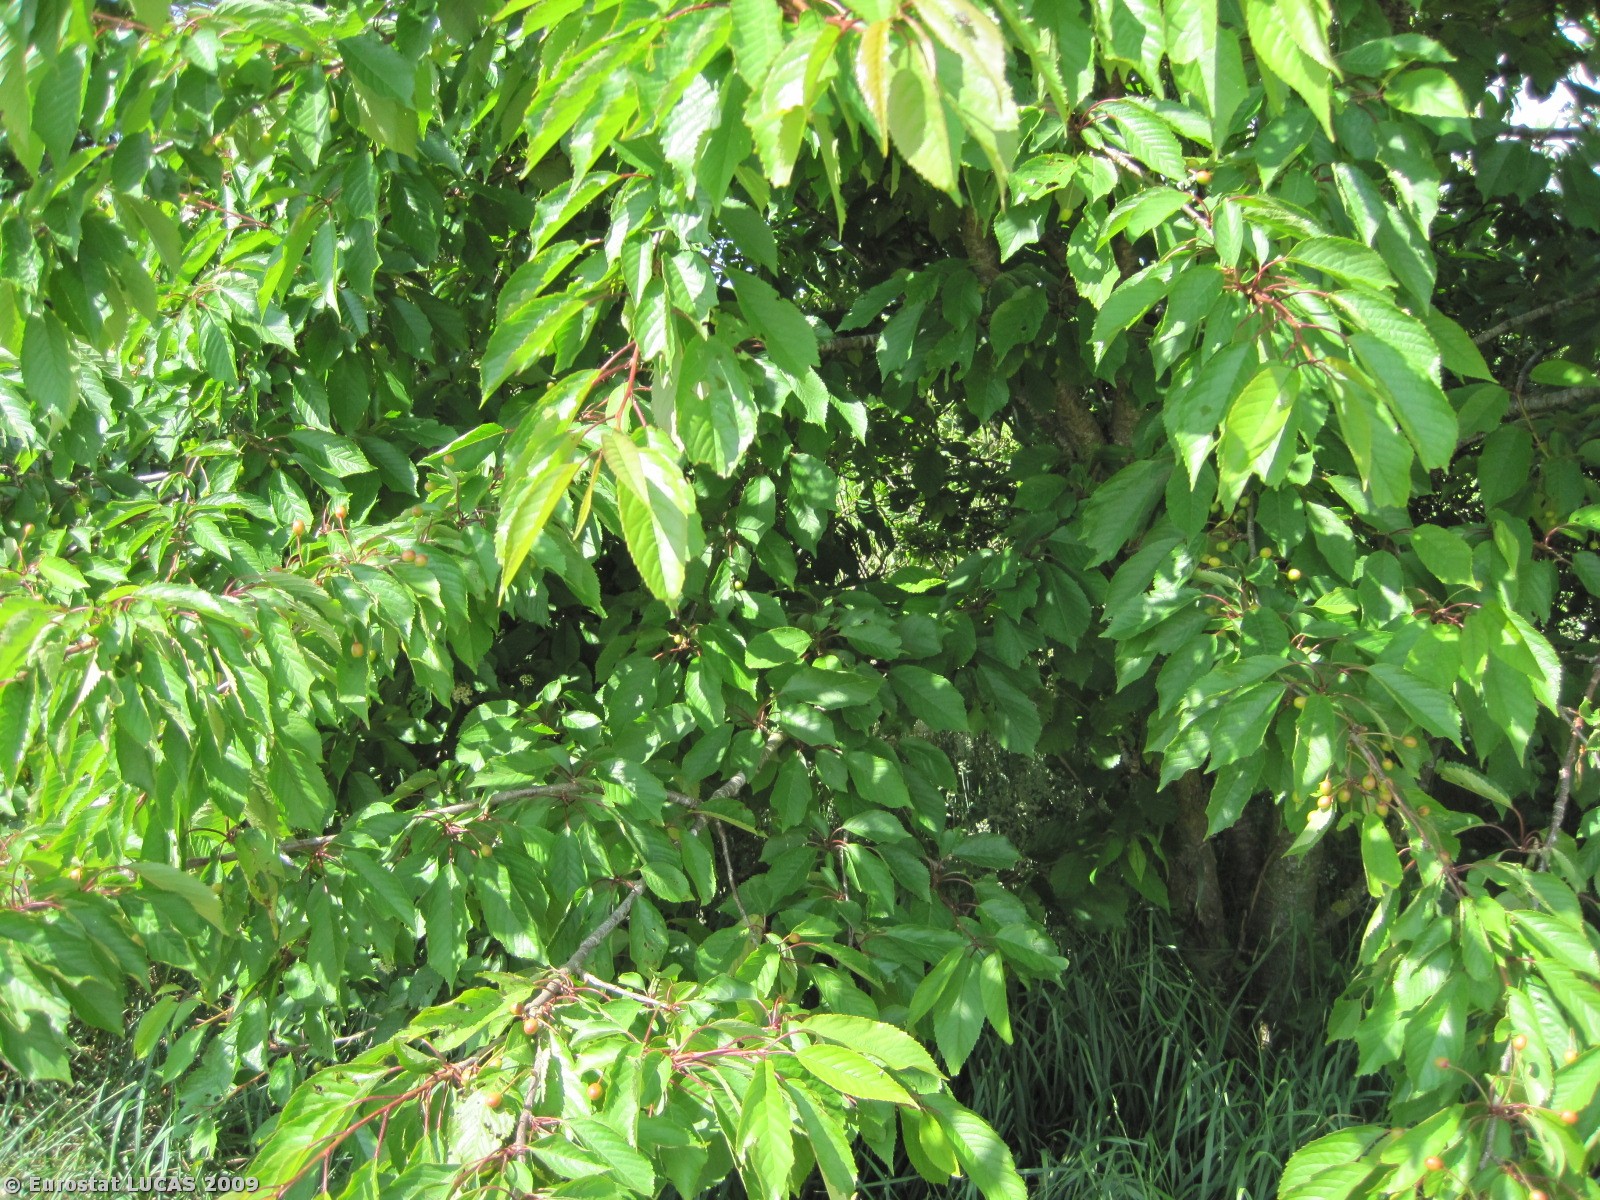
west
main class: Cropland
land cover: Barley
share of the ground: > 75 %
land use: Agriculture (excluding fallow land and kitchen gardens)
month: June
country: DK
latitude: 56.5609
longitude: 8.9437
